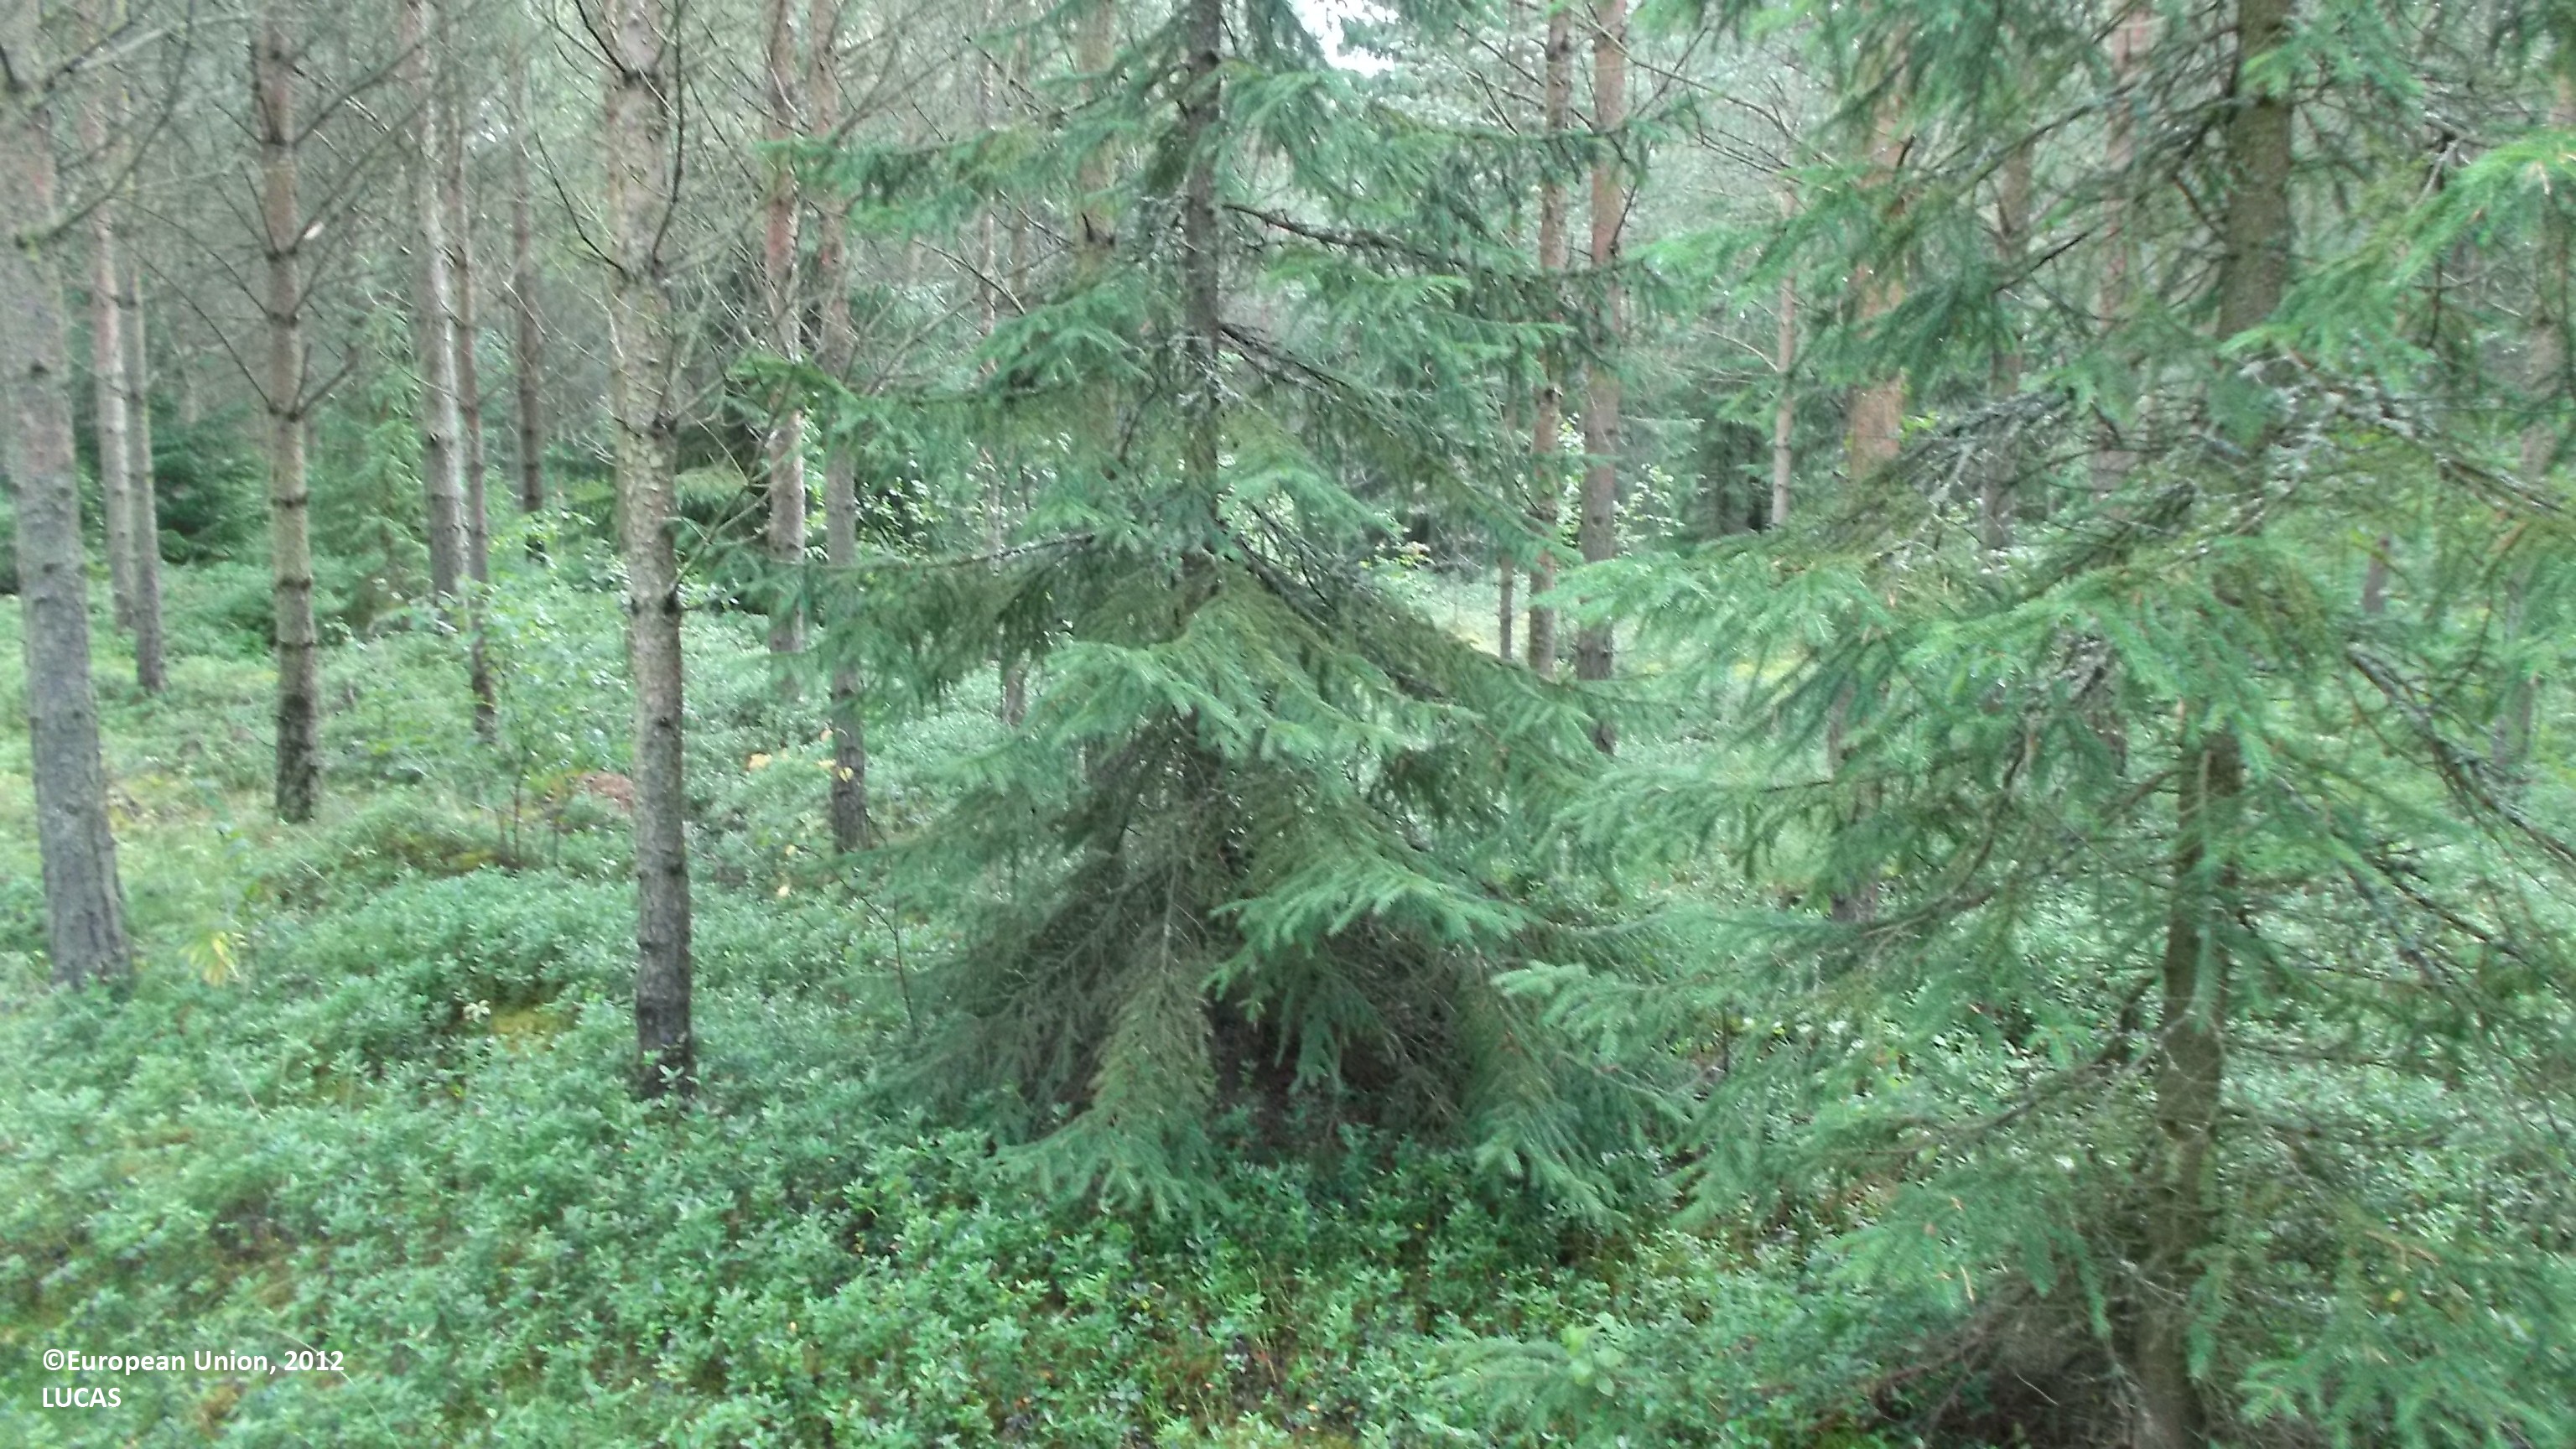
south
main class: Woodland
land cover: Pine dominated mixed woodland
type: boreal forest
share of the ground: 50 - 75 %
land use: Forestry
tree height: > 5 m
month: August
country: FI
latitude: 64.0237
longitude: 23.4595
